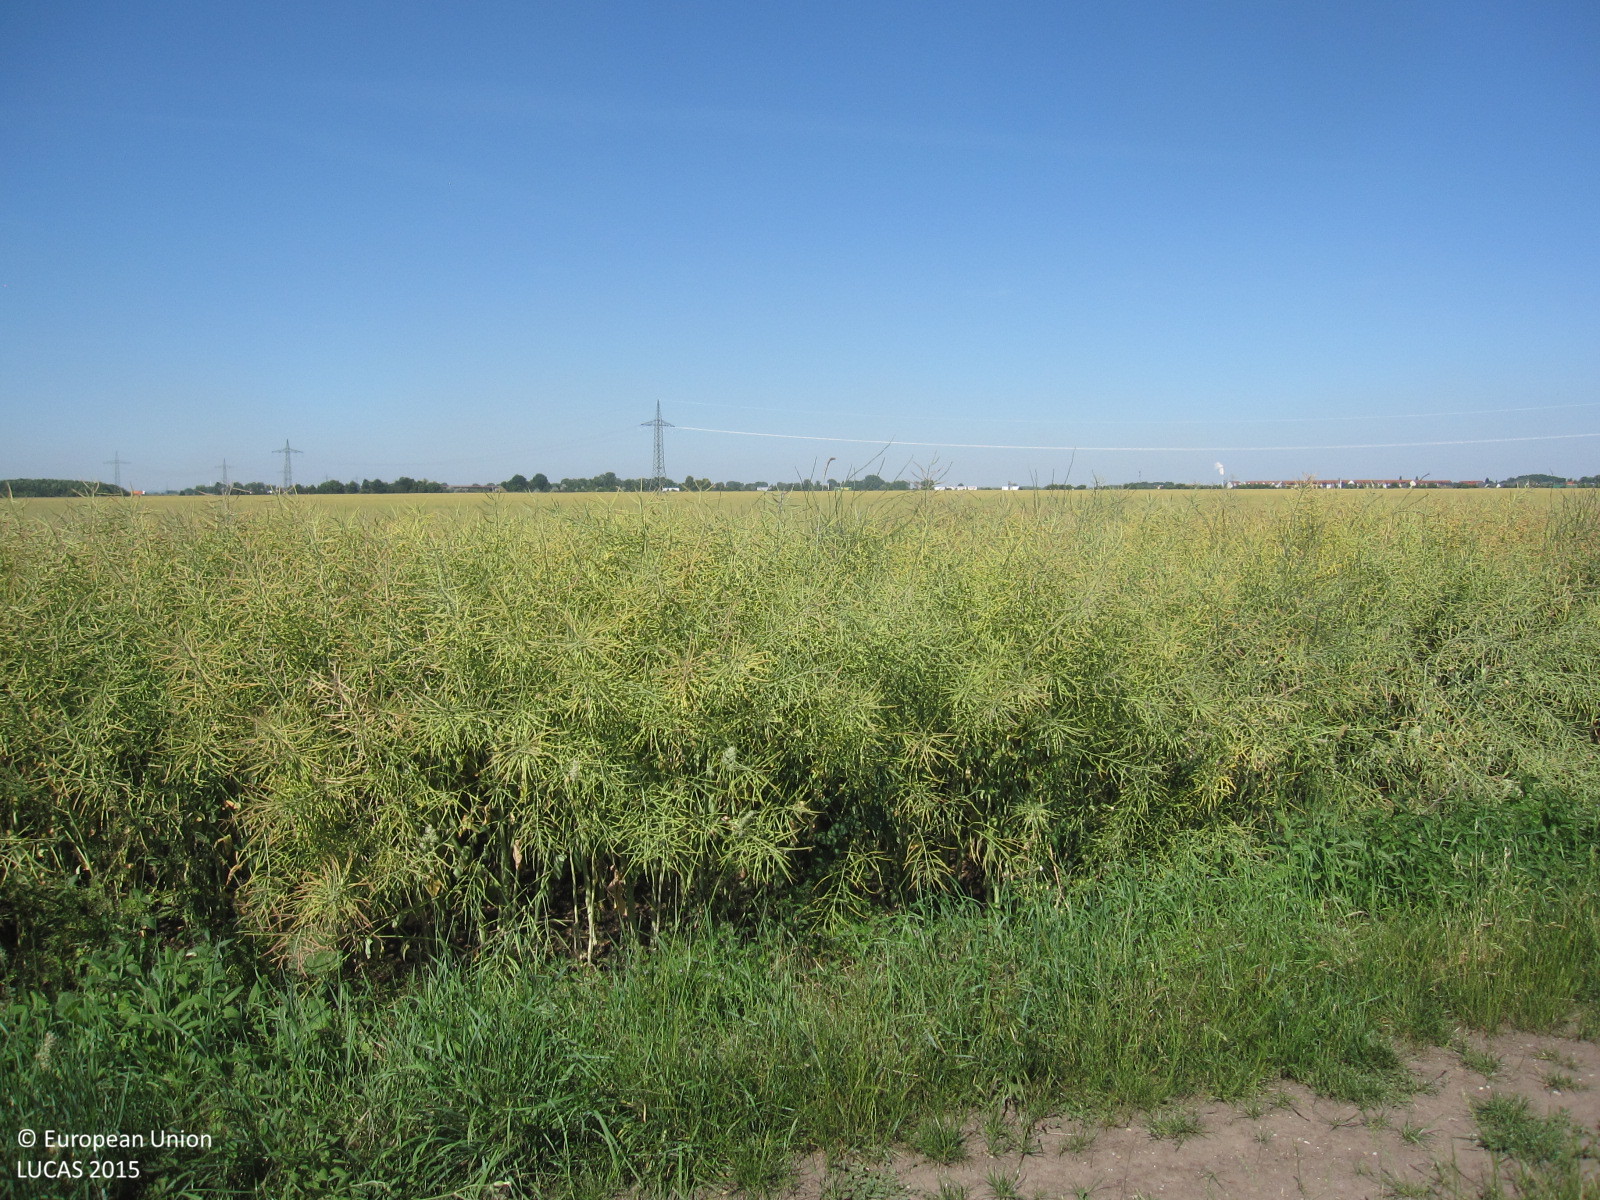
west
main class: Cropland
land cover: Rape and turnip rape
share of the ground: > 75 %
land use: Agriculture (excluding fallow land and kitchen gardens)
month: July
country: DE
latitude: 51.3322
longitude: 12.1956
